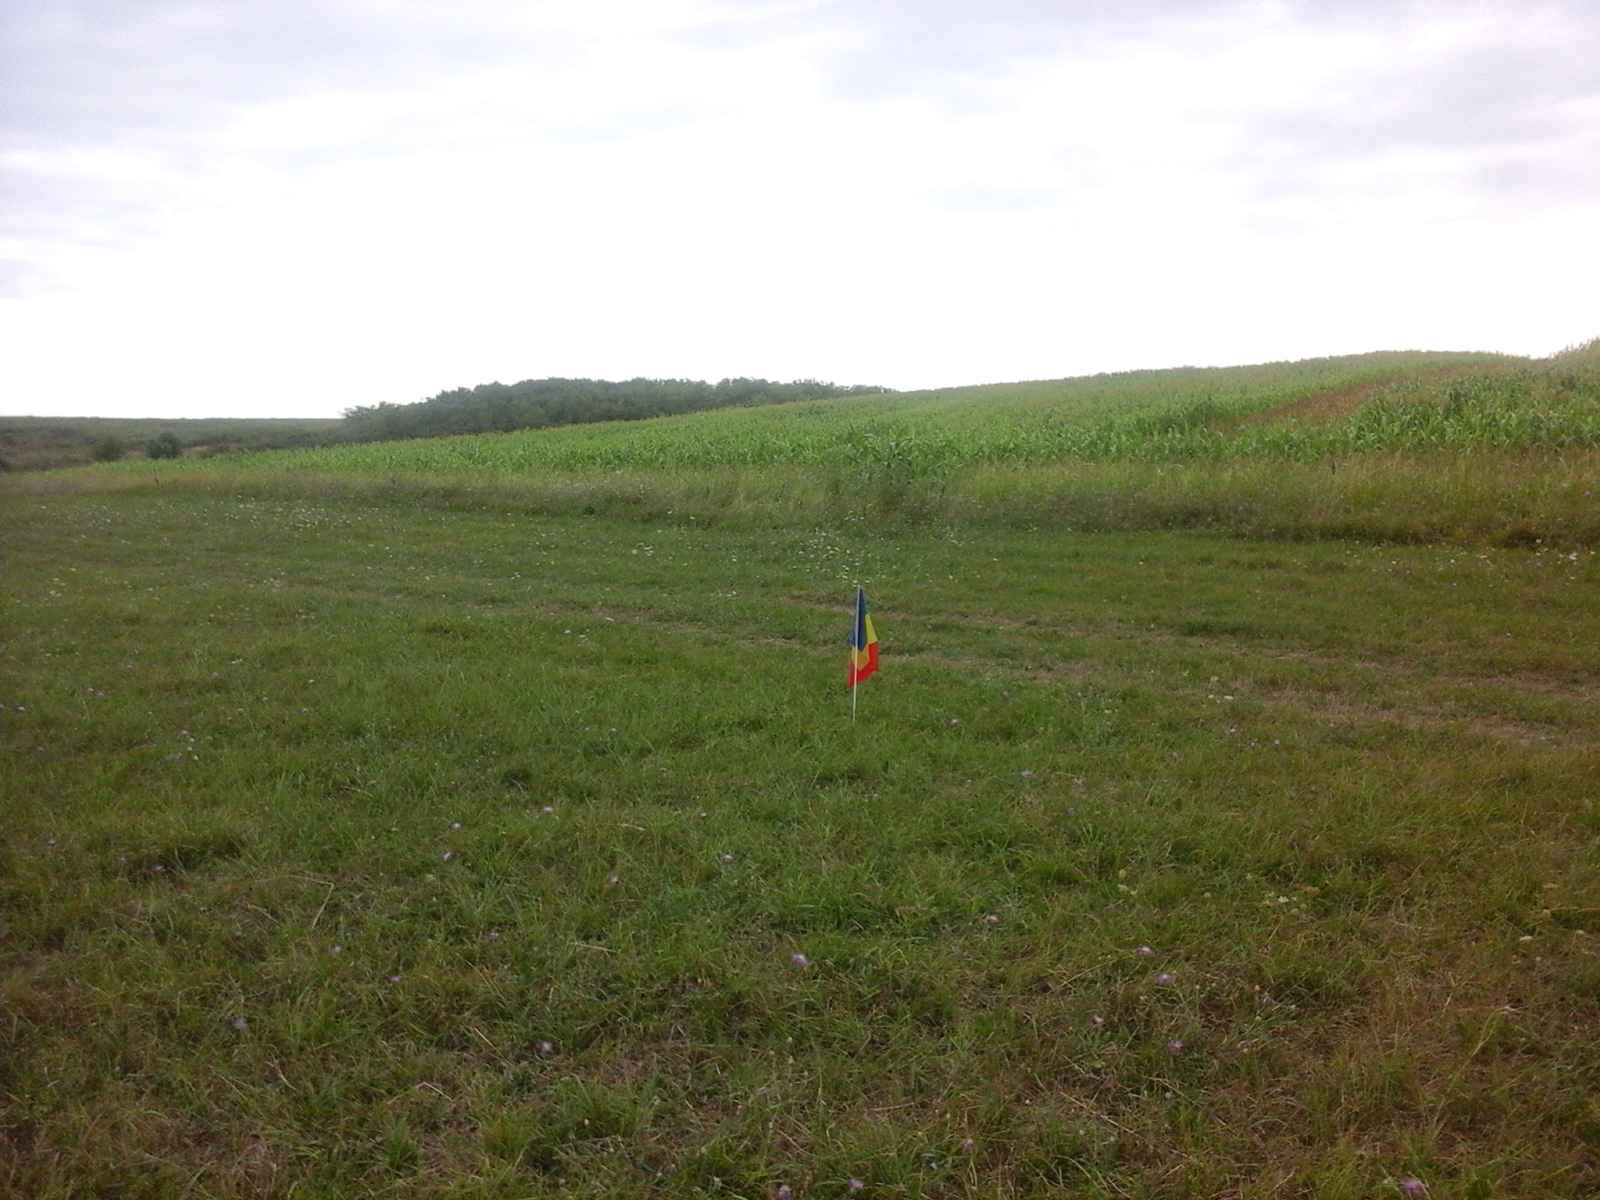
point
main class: Grassland
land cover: Grassland without tree/shrub cover
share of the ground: > 75 %
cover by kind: herbaceous plants 100 %
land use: Agriculture (excluding fallow land and kitchen gardens)
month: August
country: RO
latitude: 45.5172
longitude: 21.4378
